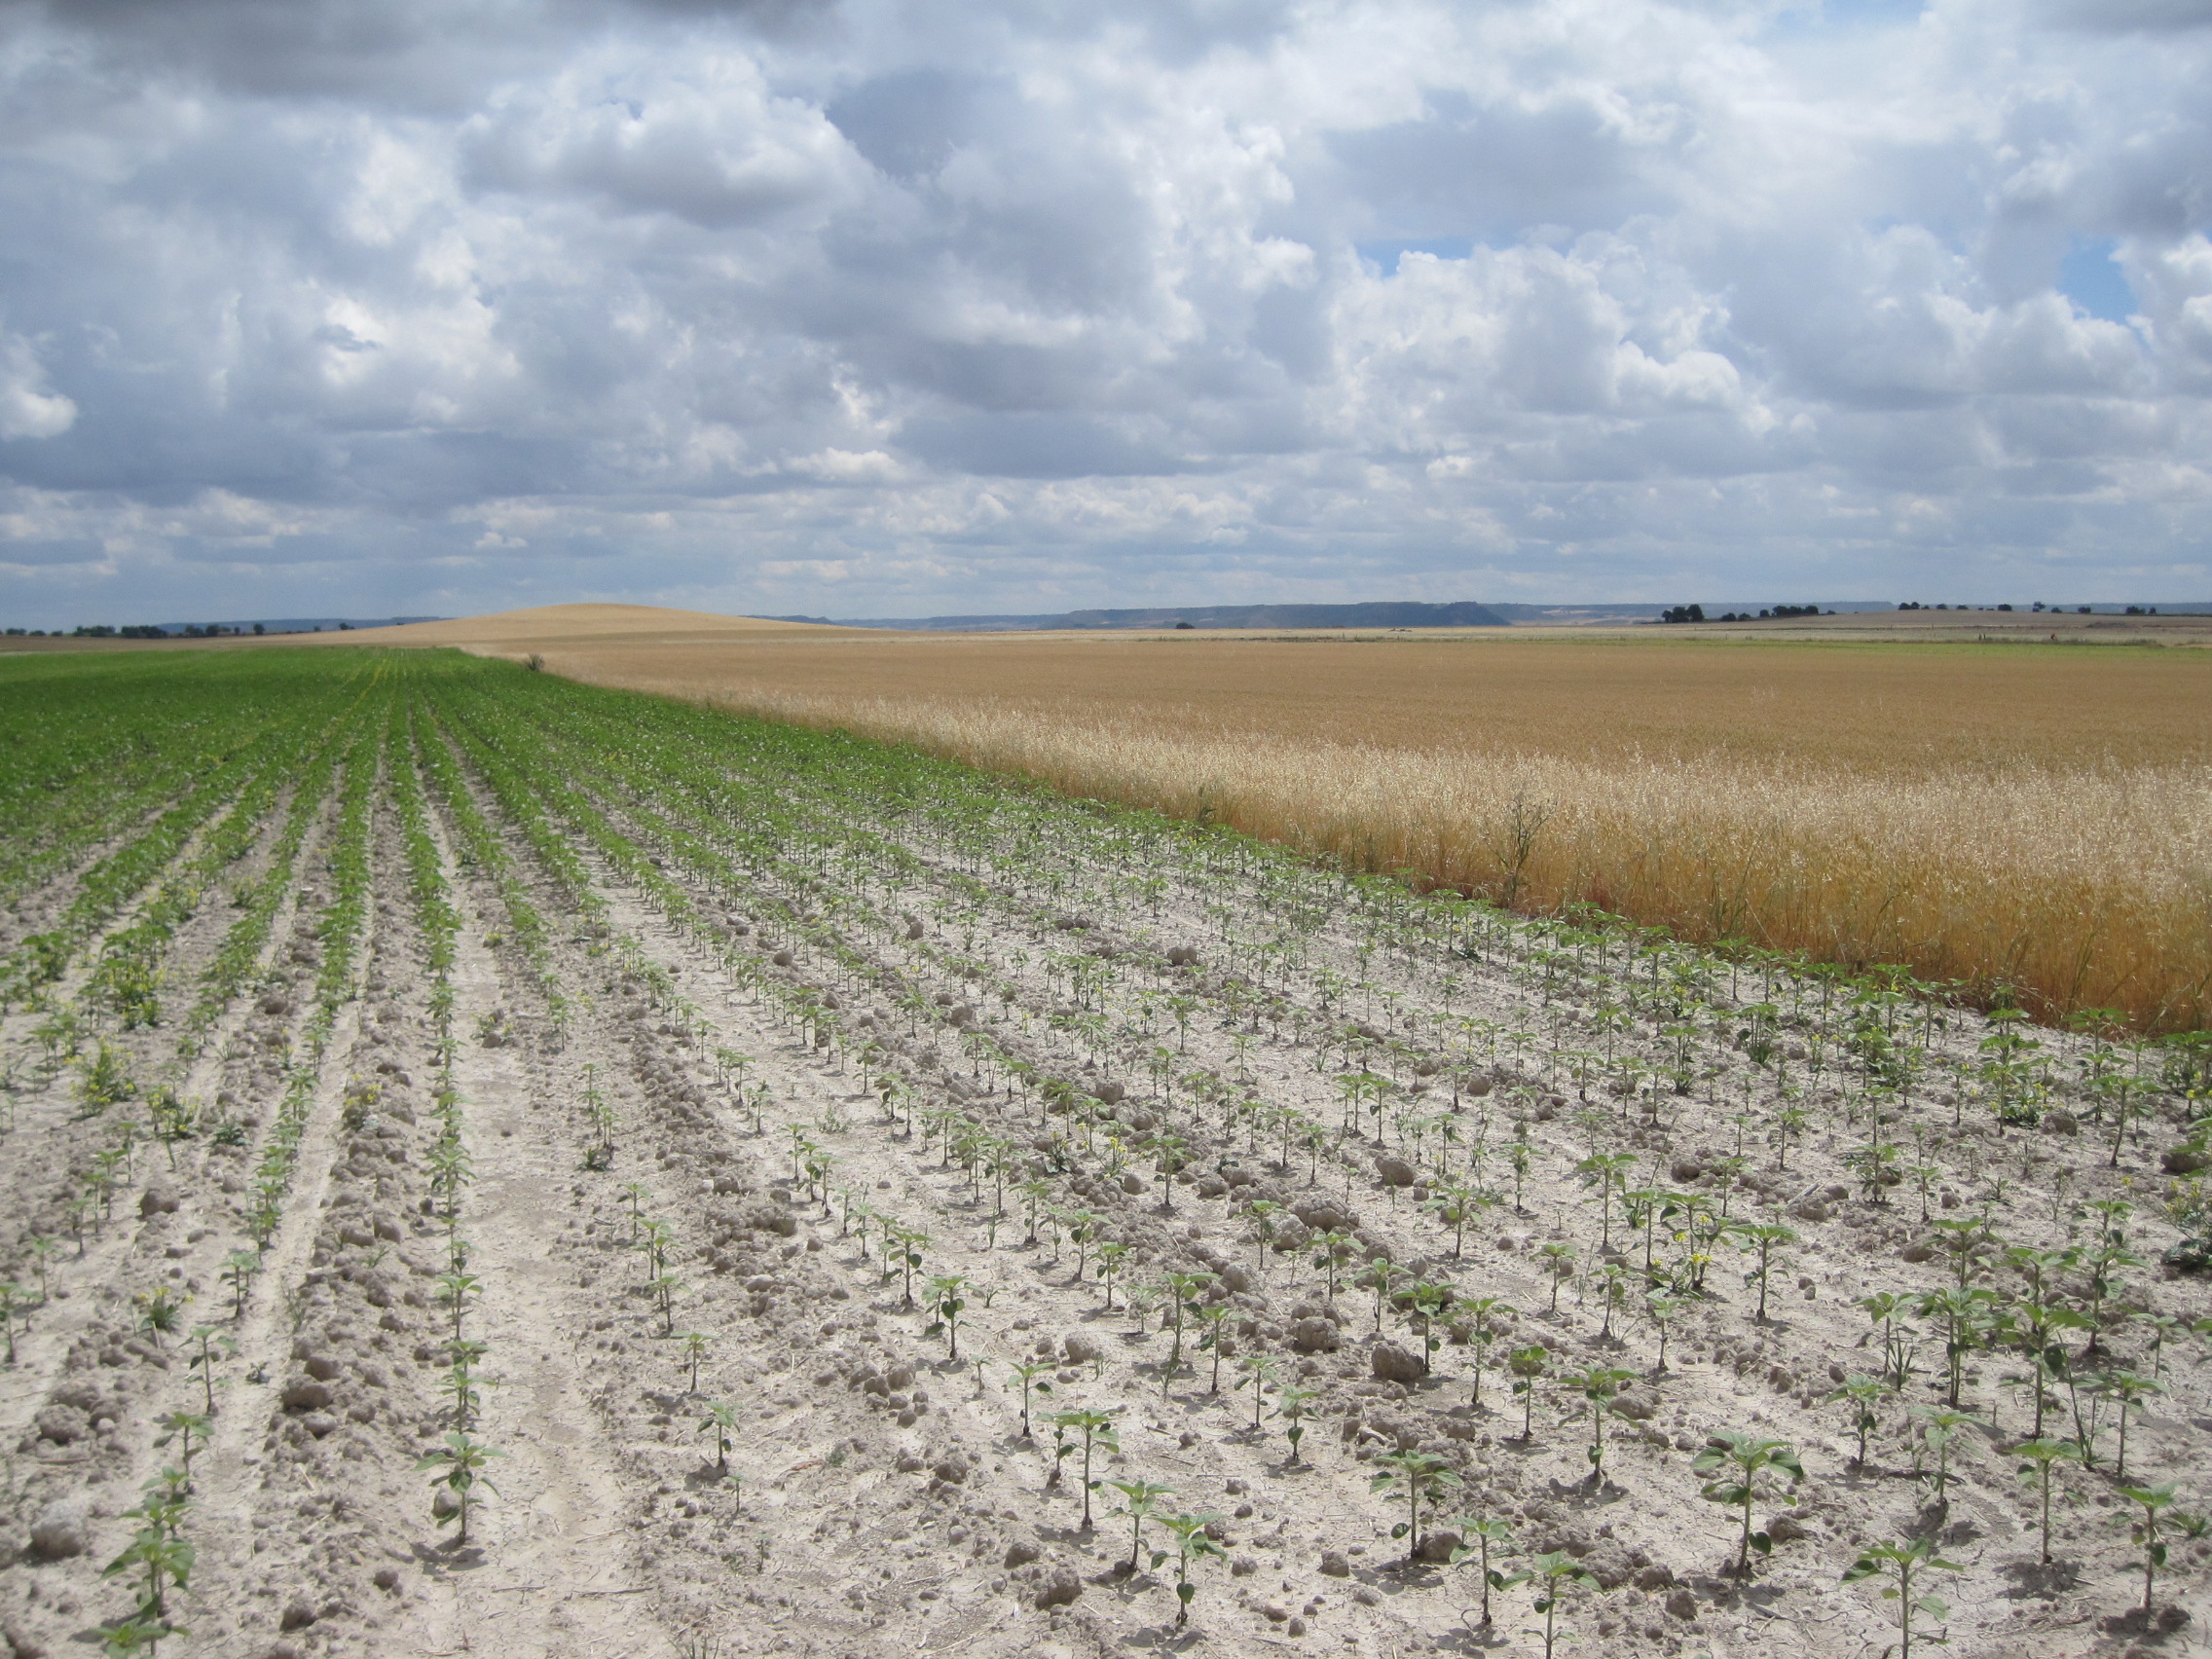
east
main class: Cropland
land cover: Sunflower
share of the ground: 25 - 50 %
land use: Agriculture (excluding fallow land and kitchen gardens)
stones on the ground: < 10 %
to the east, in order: Sunflower; Grass margins; Common wheat
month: June
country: ES
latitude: 41.7959
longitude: -4.6921
